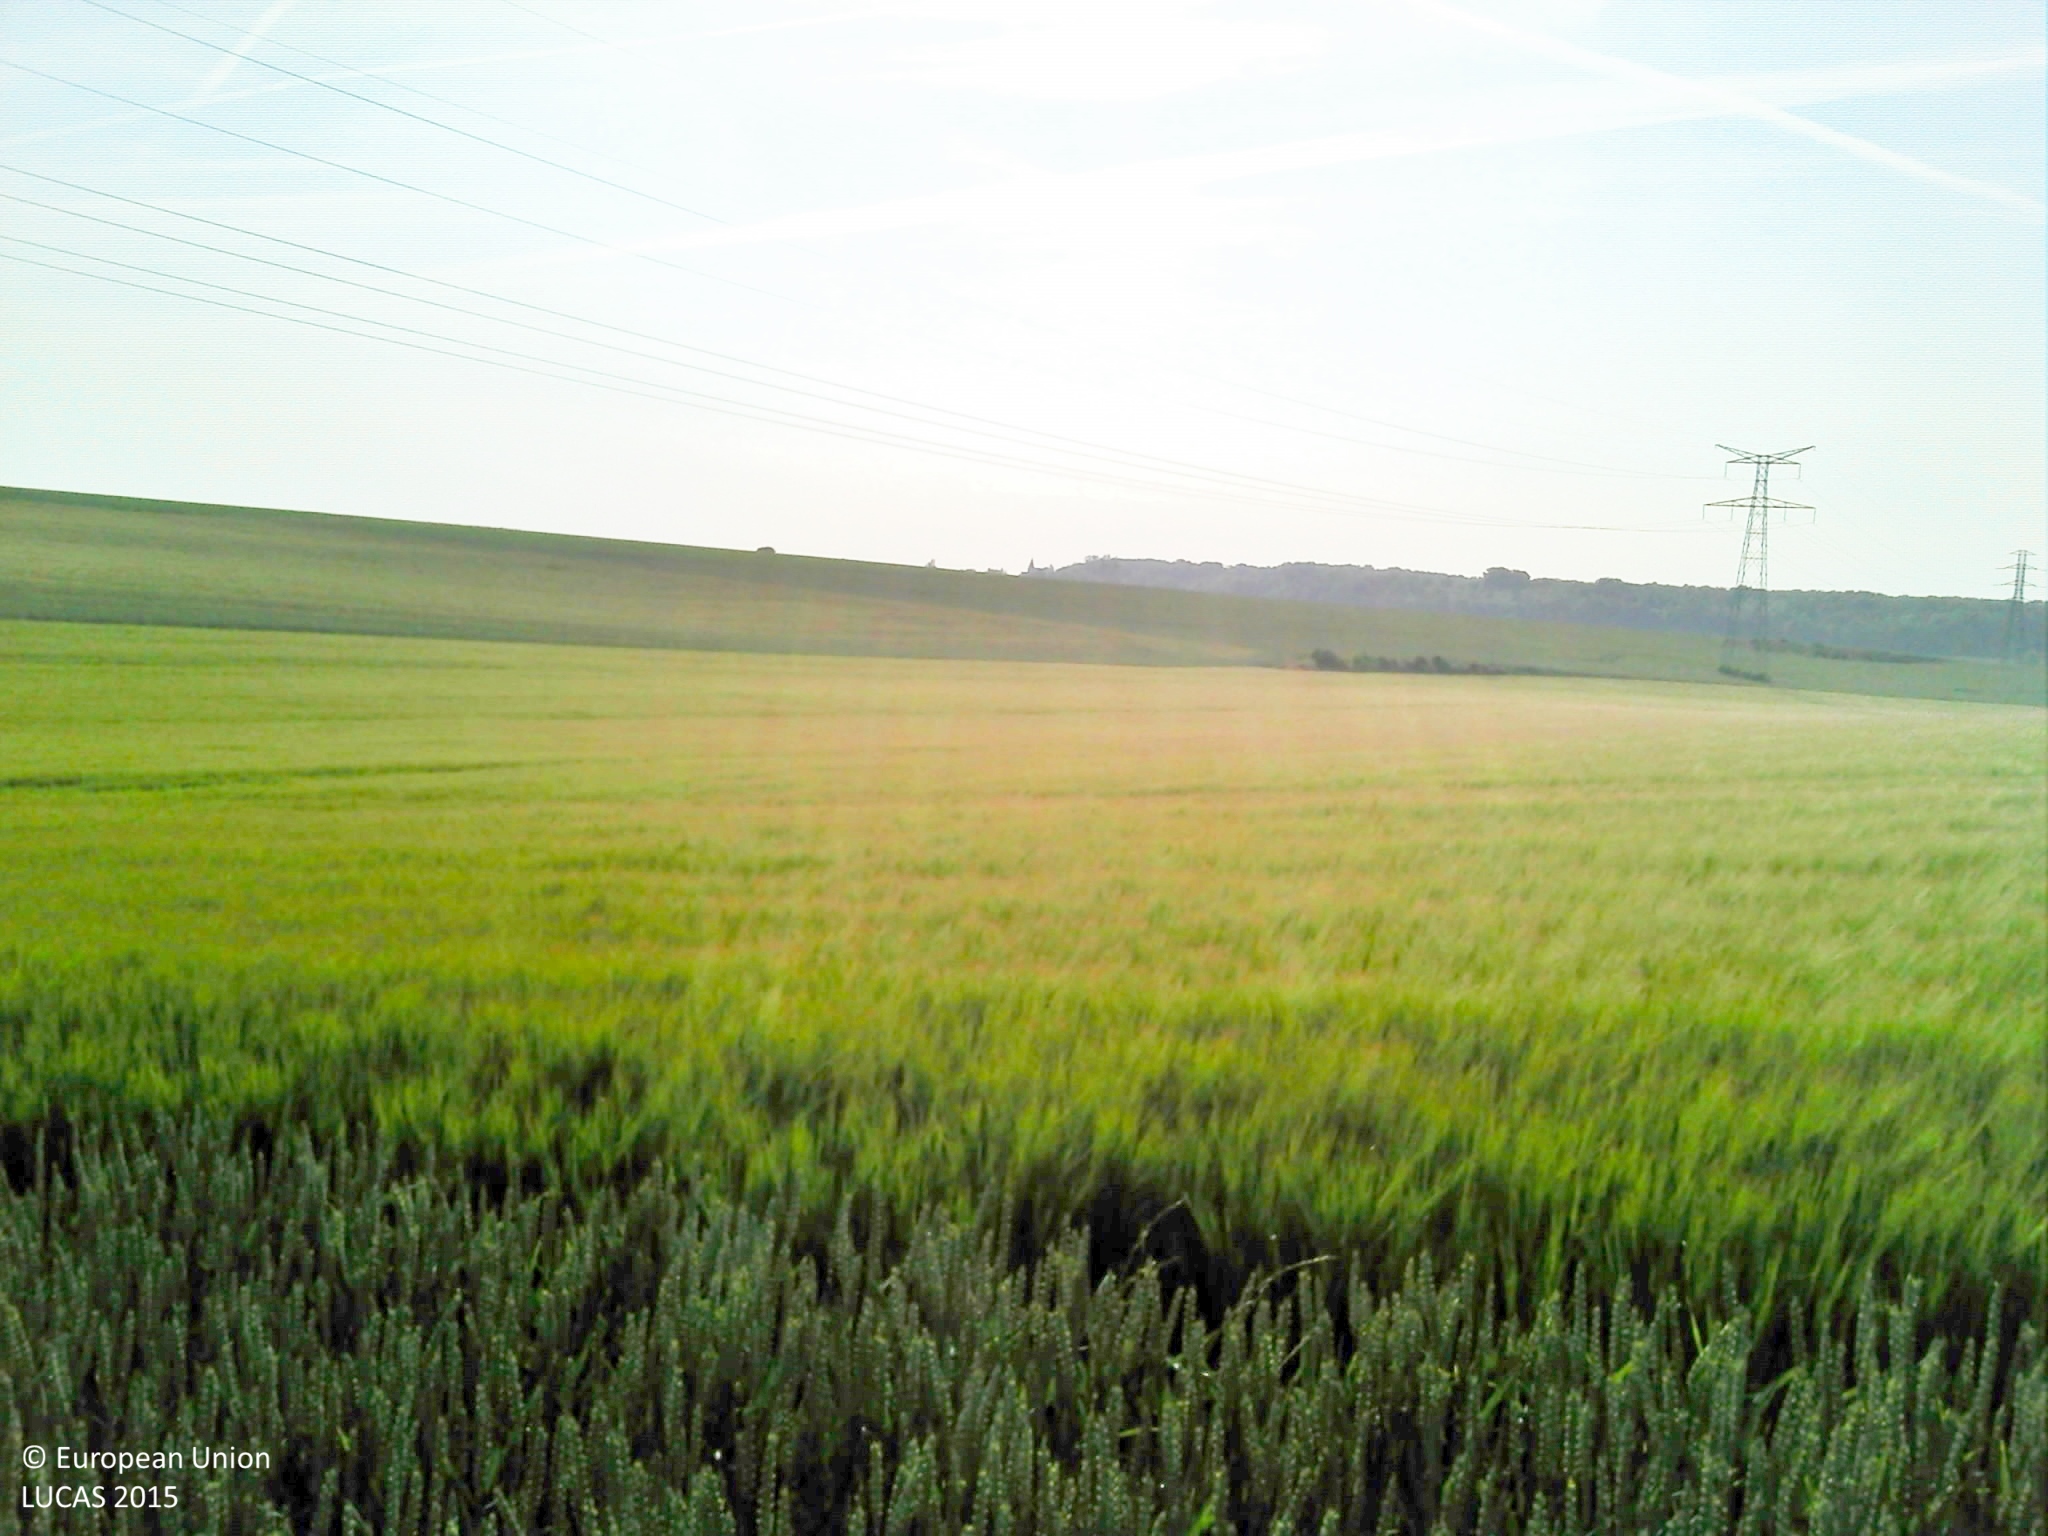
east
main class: Cropland
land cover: Common wheat
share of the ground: > 75 %
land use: Agriculture (excluding fallow land and kitchen gardens)
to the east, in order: Common wheat; Barley; Electric lines; Barley; Common wheat
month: June
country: FR
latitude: 49.4690
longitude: 2.5228
